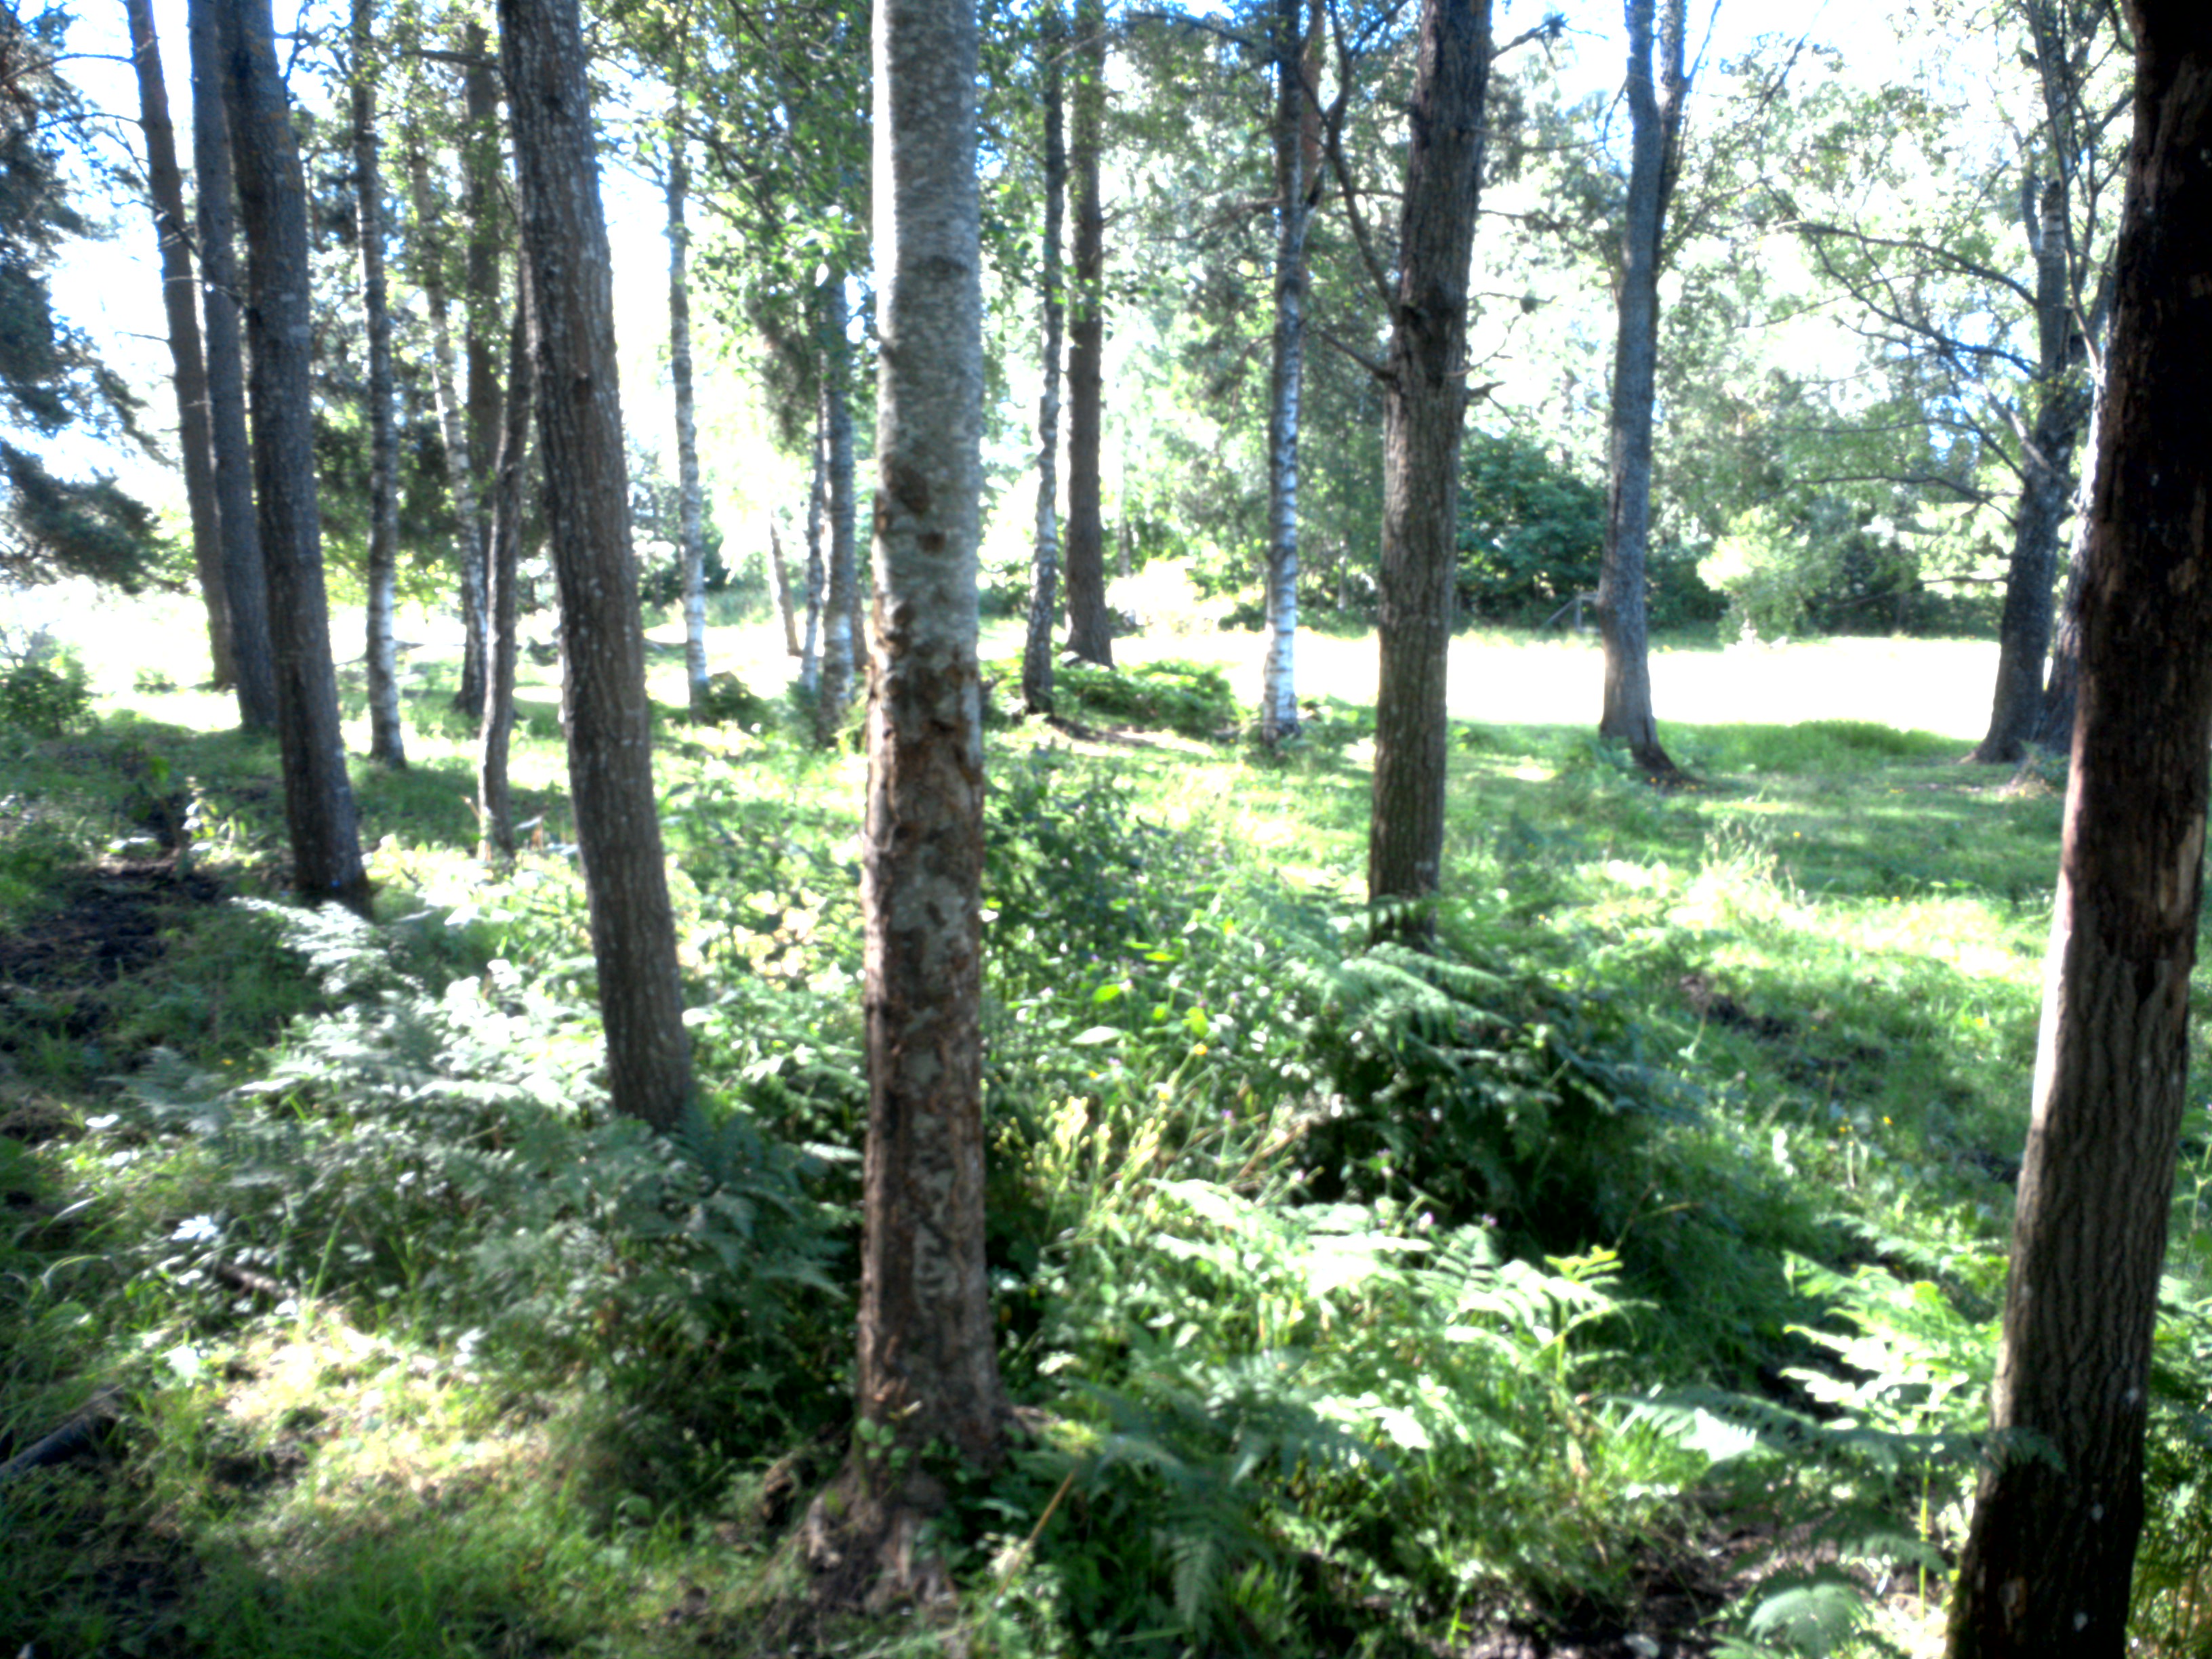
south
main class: Woodland
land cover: Broadleaved woodland
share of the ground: 50 - 75 %
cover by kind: herbaceous plants 50 %, broadleaved forest trees 40 %, coniferous forest trees 10 %
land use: Agriculture (excluding fallow land and kitchen gardens)
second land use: Forestry
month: August
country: SE
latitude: 59.1714
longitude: 17.7479
